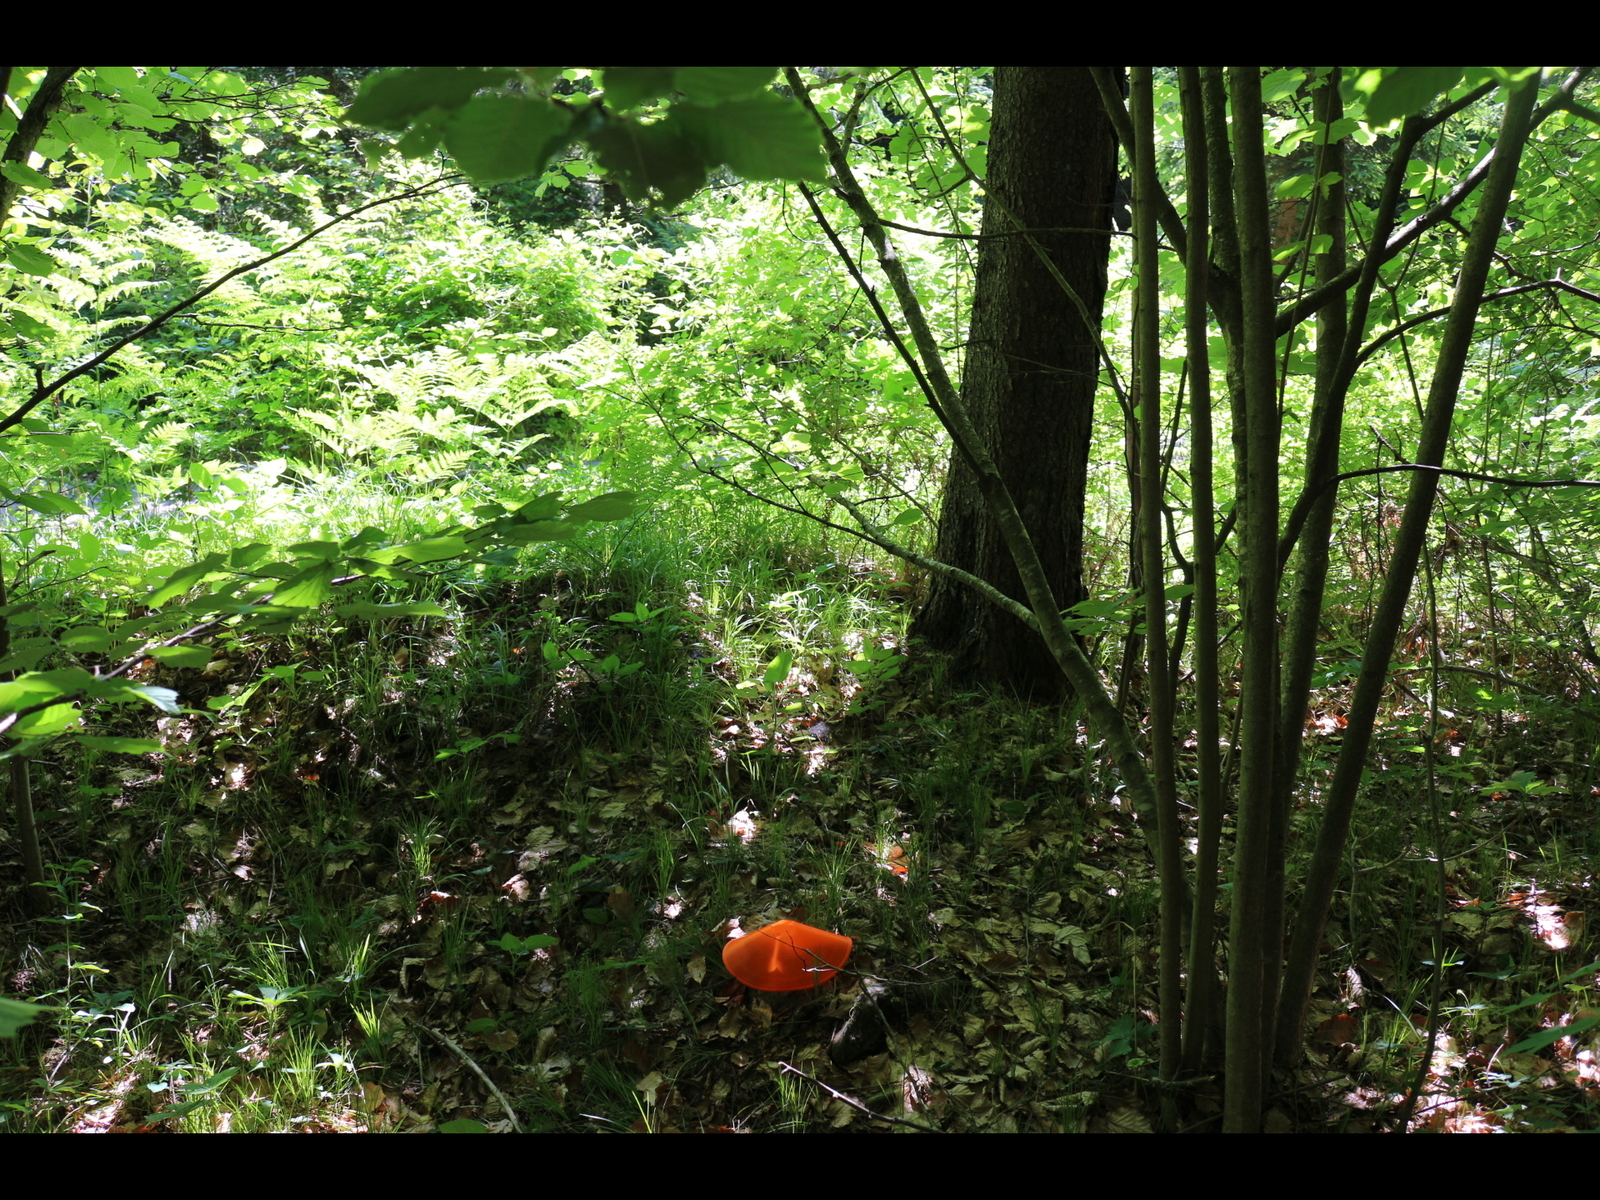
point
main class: Woodland
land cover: Spruce dominated mixed woodland
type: alpine coniferous forest
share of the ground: > 75 %
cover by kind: coniferous forest trees 70 %, broadleaved forest trees 30 %
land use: Forestry
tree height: > 5 m
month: May
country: AT
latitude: 46.5240
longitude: 14.1296
